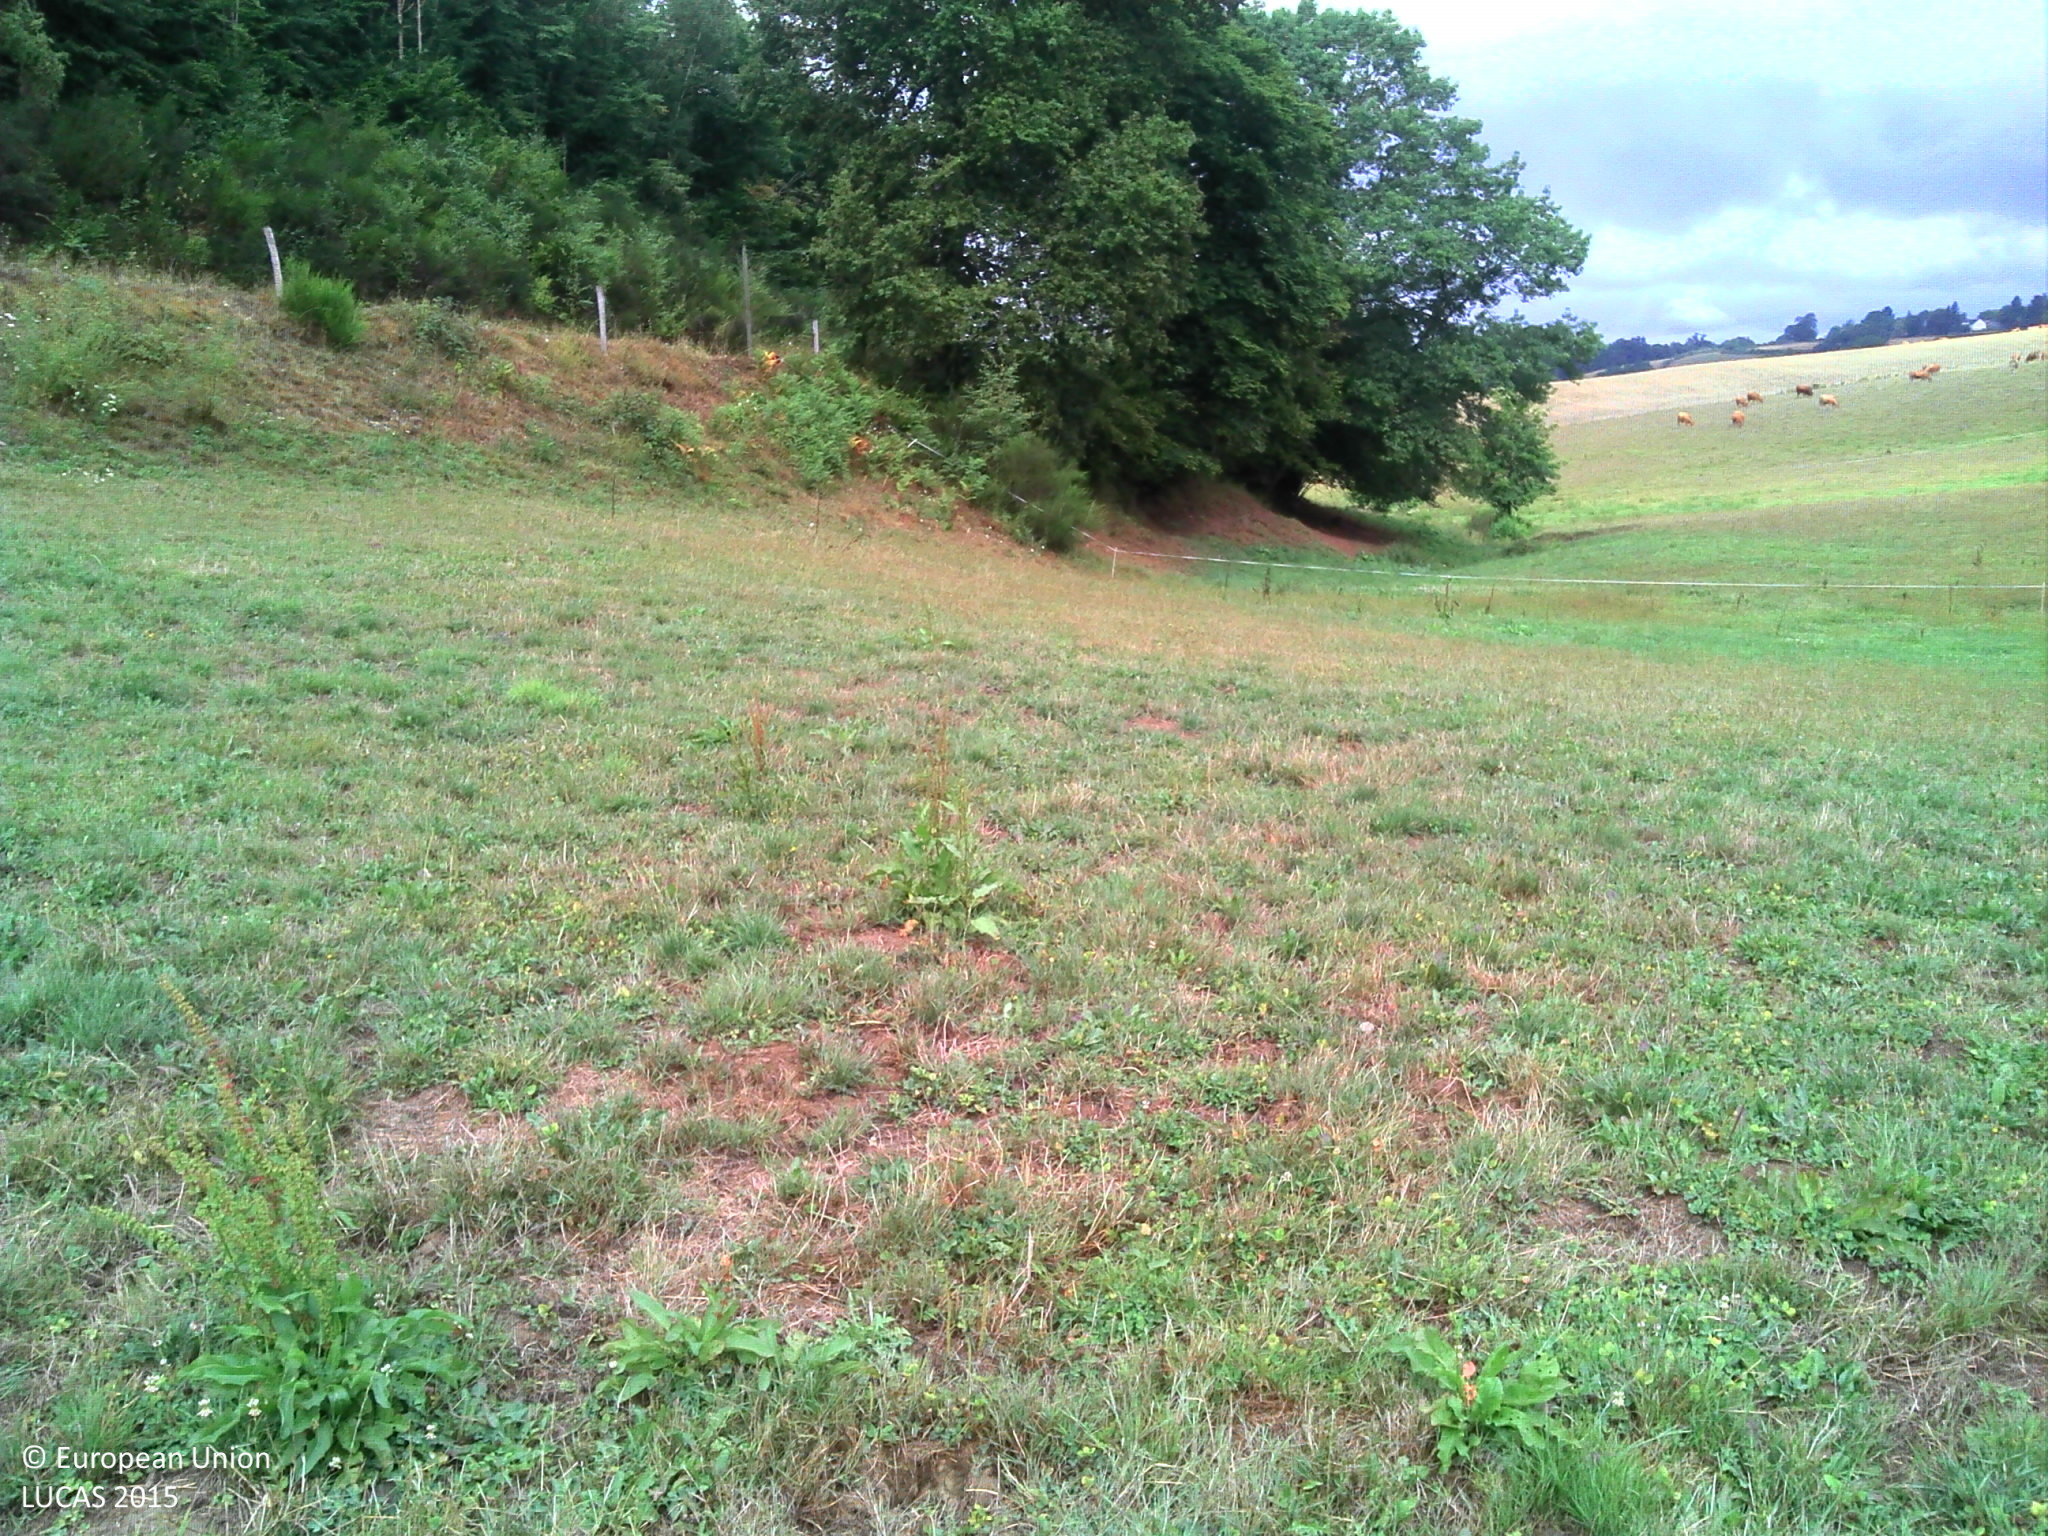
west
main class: Grassland
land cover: Grassland without tree/shrub cover
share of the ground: > 75 %
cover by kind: herbaceous plants 100 %
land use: Agriculture (excluding fallow land and kitchen gardens)
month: August
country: FR
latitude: 45.4108
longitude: 1.6768
